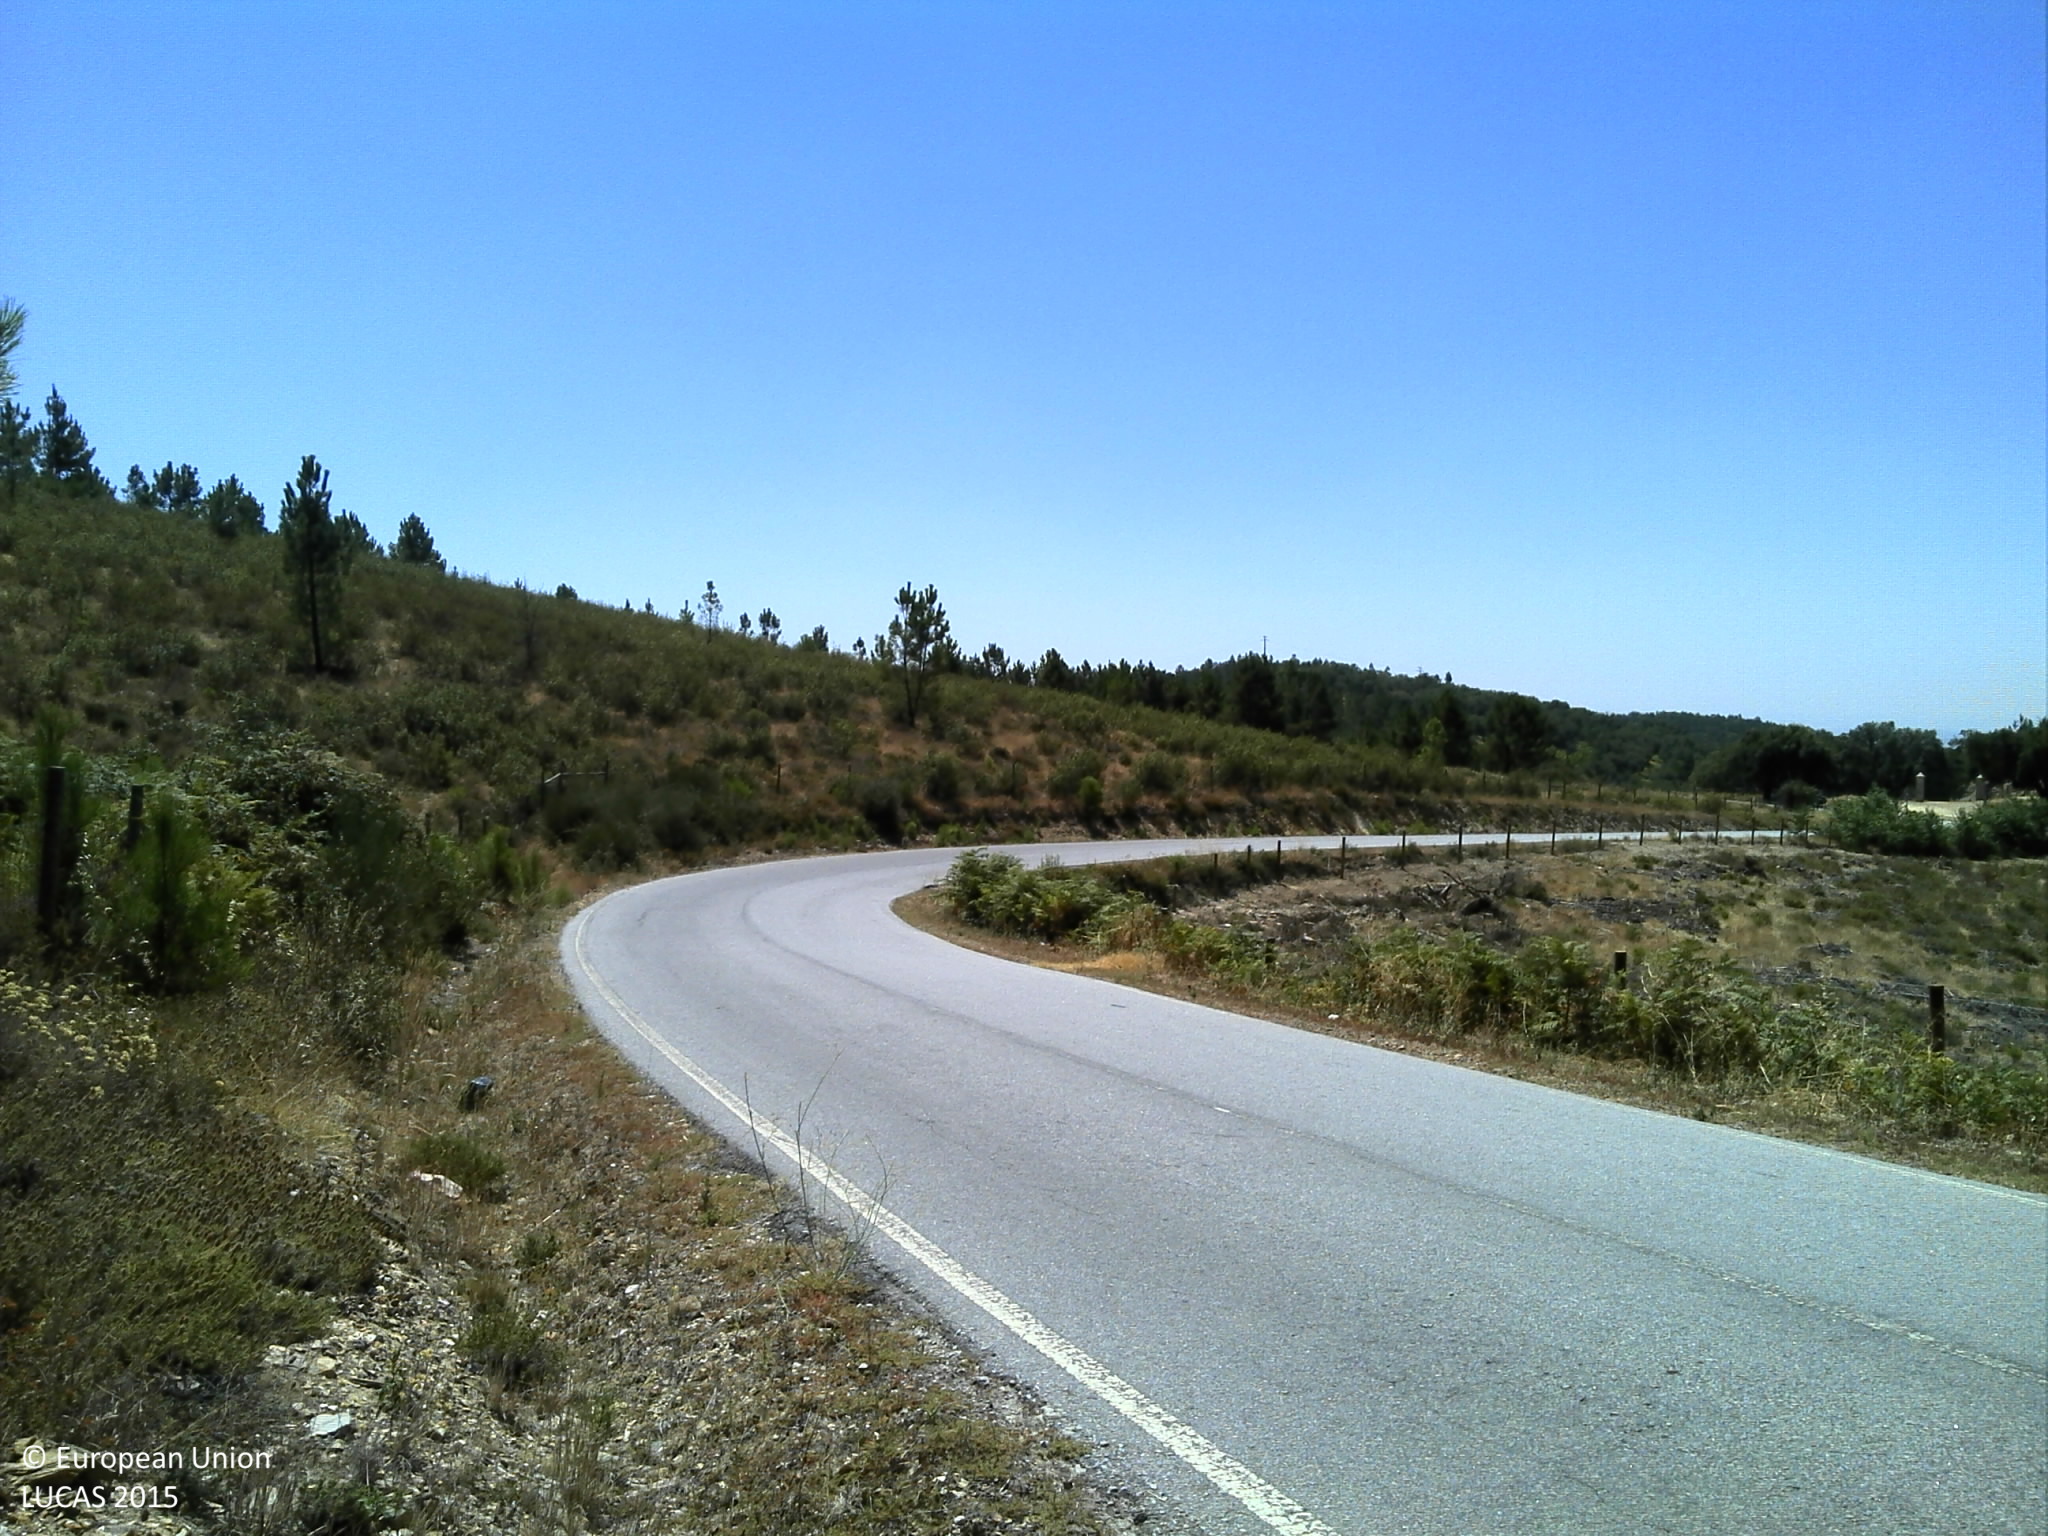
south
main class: Woodland
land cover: Pine dominated coniferous woodland
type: coniferous forest of the mediterranean region
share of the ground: 10 - 25 %
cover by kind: shrubs 85 %, coniferous forest trees 15 %
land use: Forestry
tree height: > 5 m
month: August
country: PT
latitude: 39.3119
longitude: -7.3792
